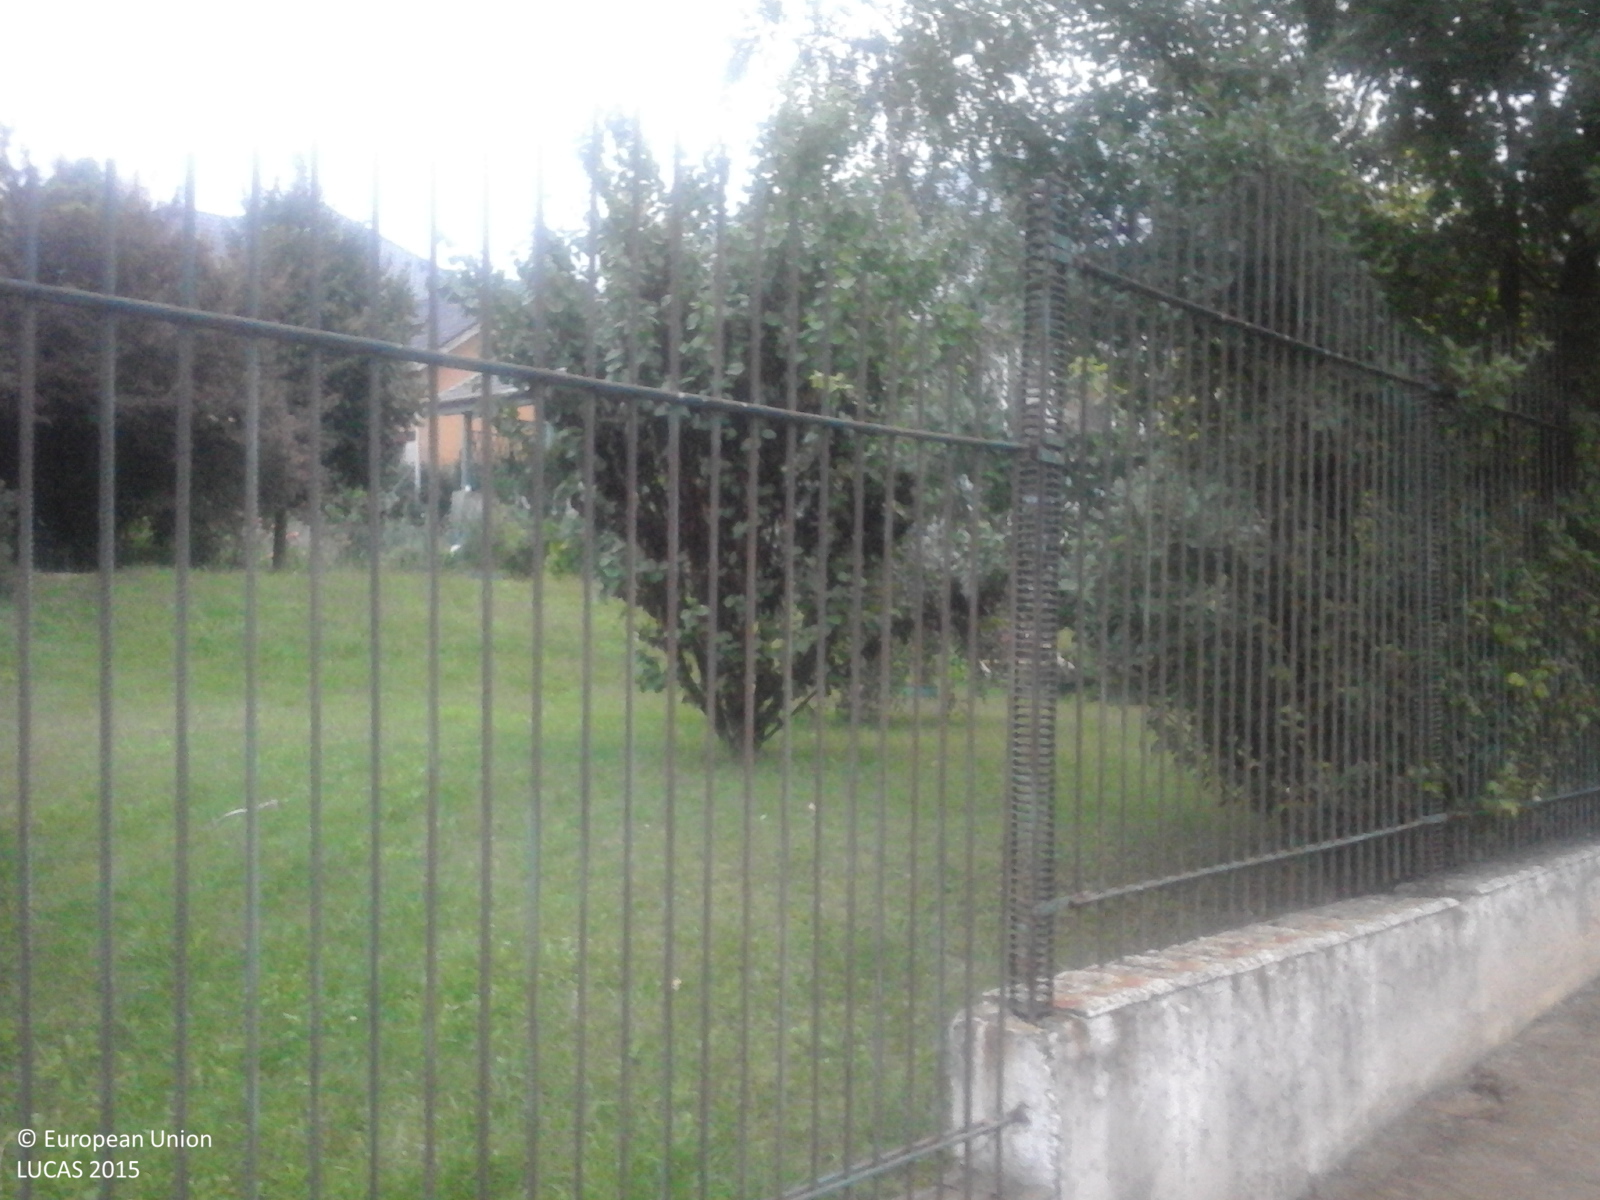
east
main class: Grassland
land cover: Spontaneously vegetated surfaces
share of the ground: > 75 %
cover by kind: herbaceous plants 100 %
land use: Residential
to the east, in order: Spontaneously vegetated surfaces; Artificial constructions in urban areas; Apple fruit; Paved roads, cycling and walking lanes; Apple fruit; Tracks; Apple fruit
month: September
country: RO
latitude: 47.0602
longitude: 21.9620
